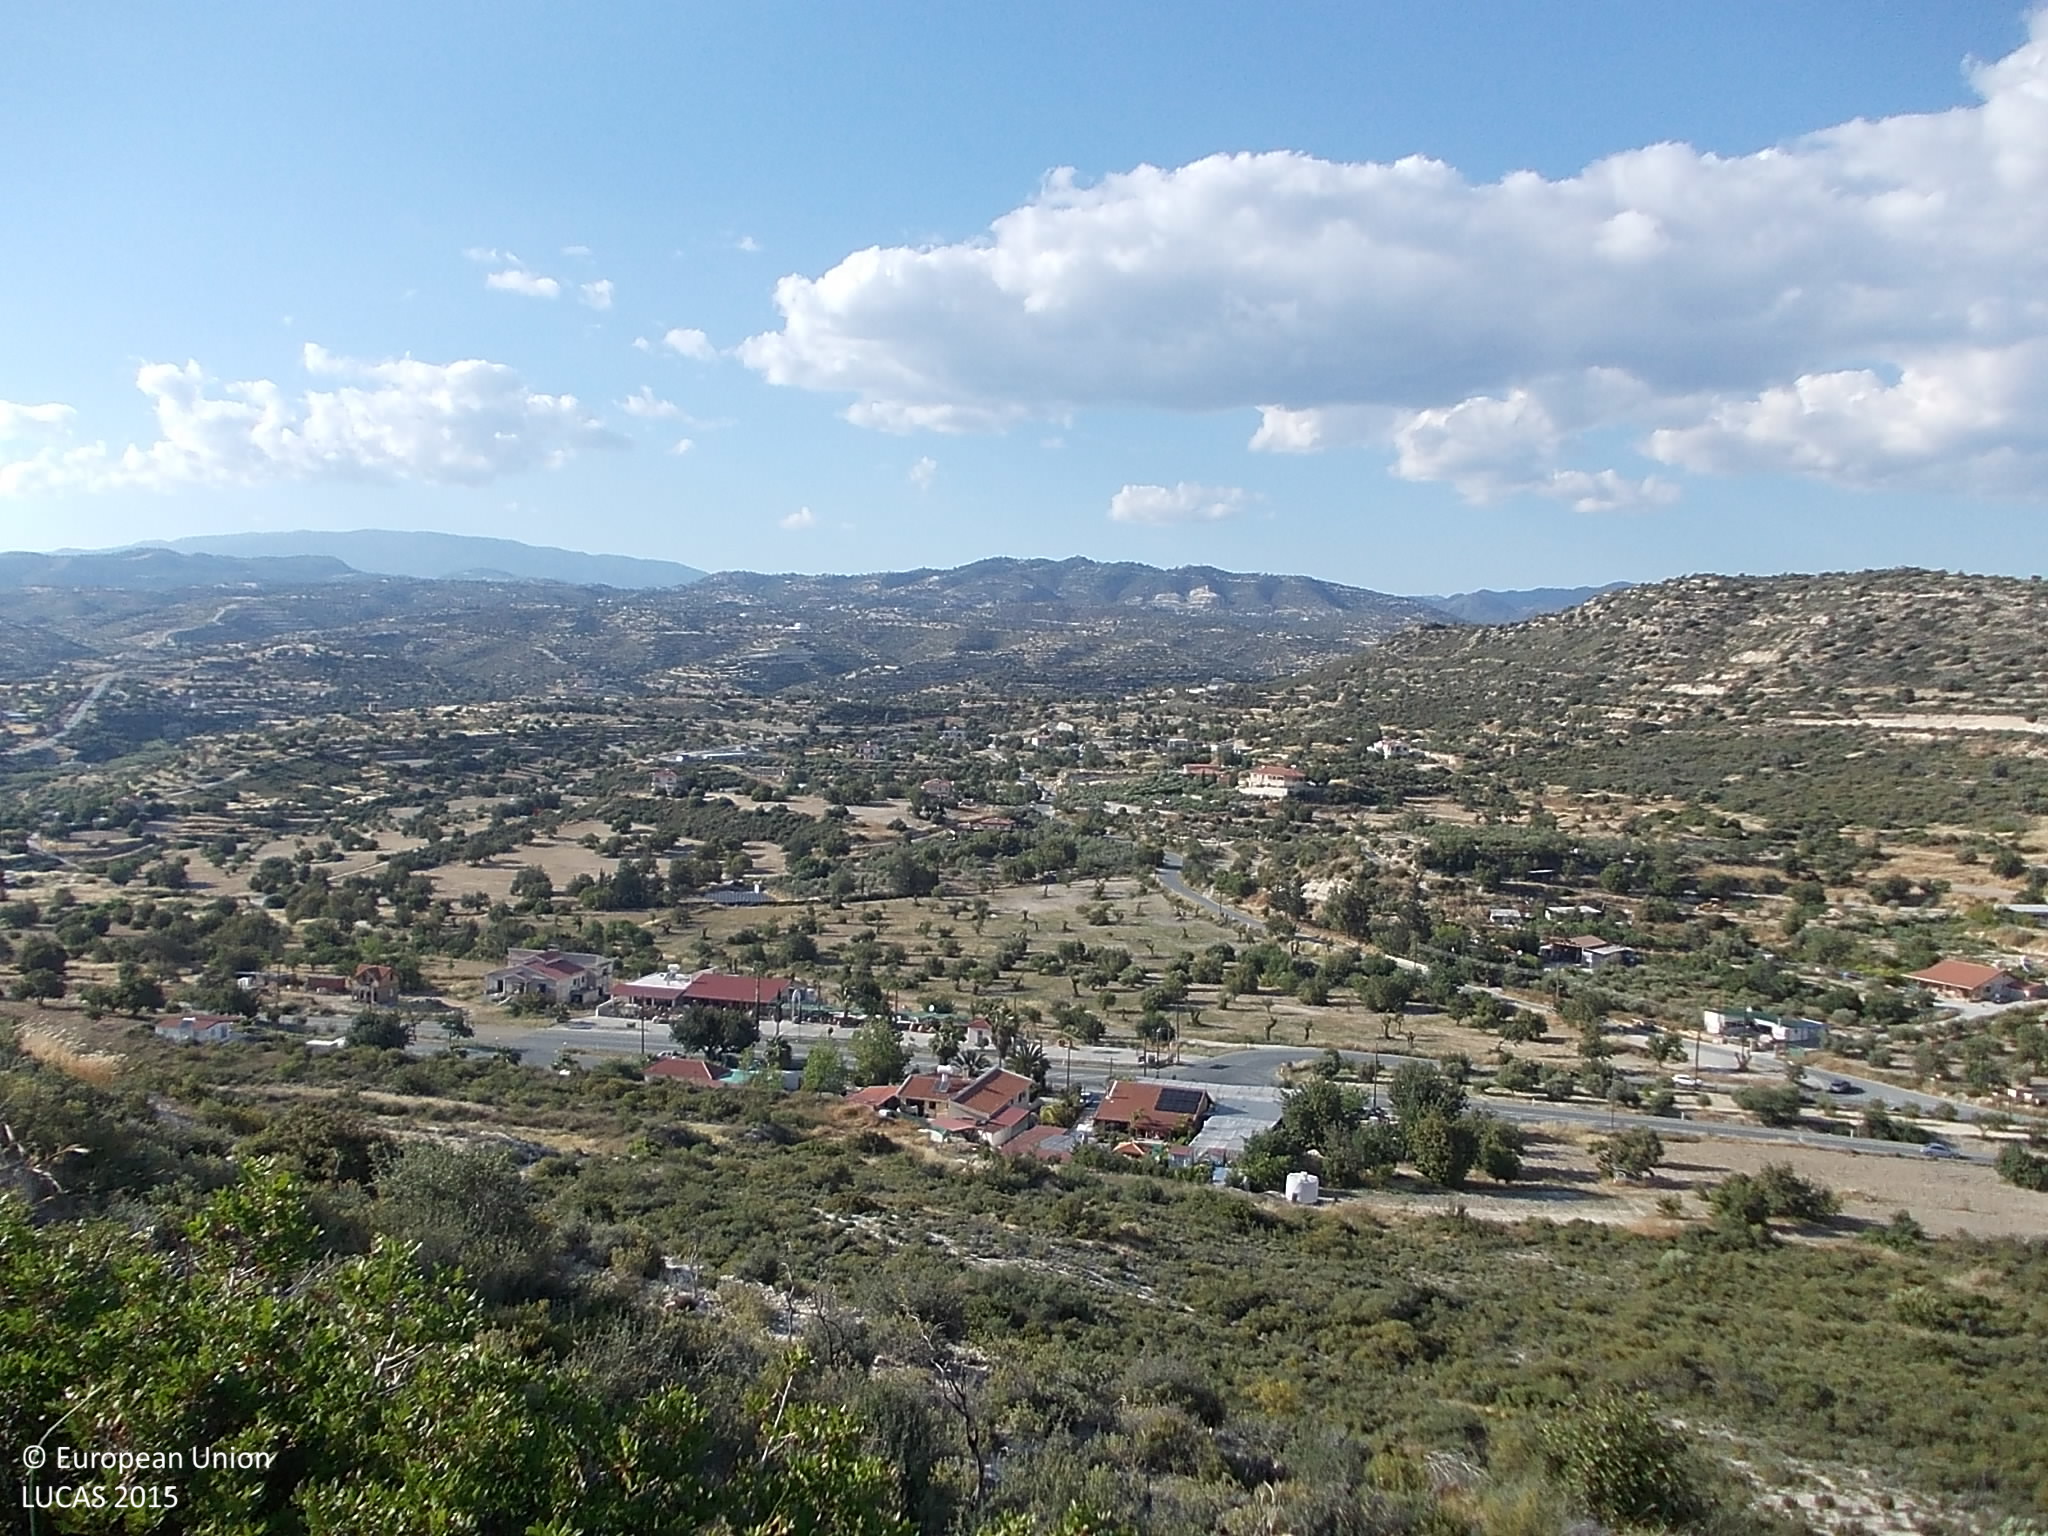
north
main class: Shrubland
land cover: Shrubland without tree cover
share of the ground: 50 - 75 %
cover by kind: shrubs 60 %, unconsolidated bare surface 20 %, herbaceous plants 15 %, consolidated bare surface 5 %
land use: Semi-natural and natural areas not in use
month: May
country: CY
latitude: 34.7424
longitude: 32.9819
